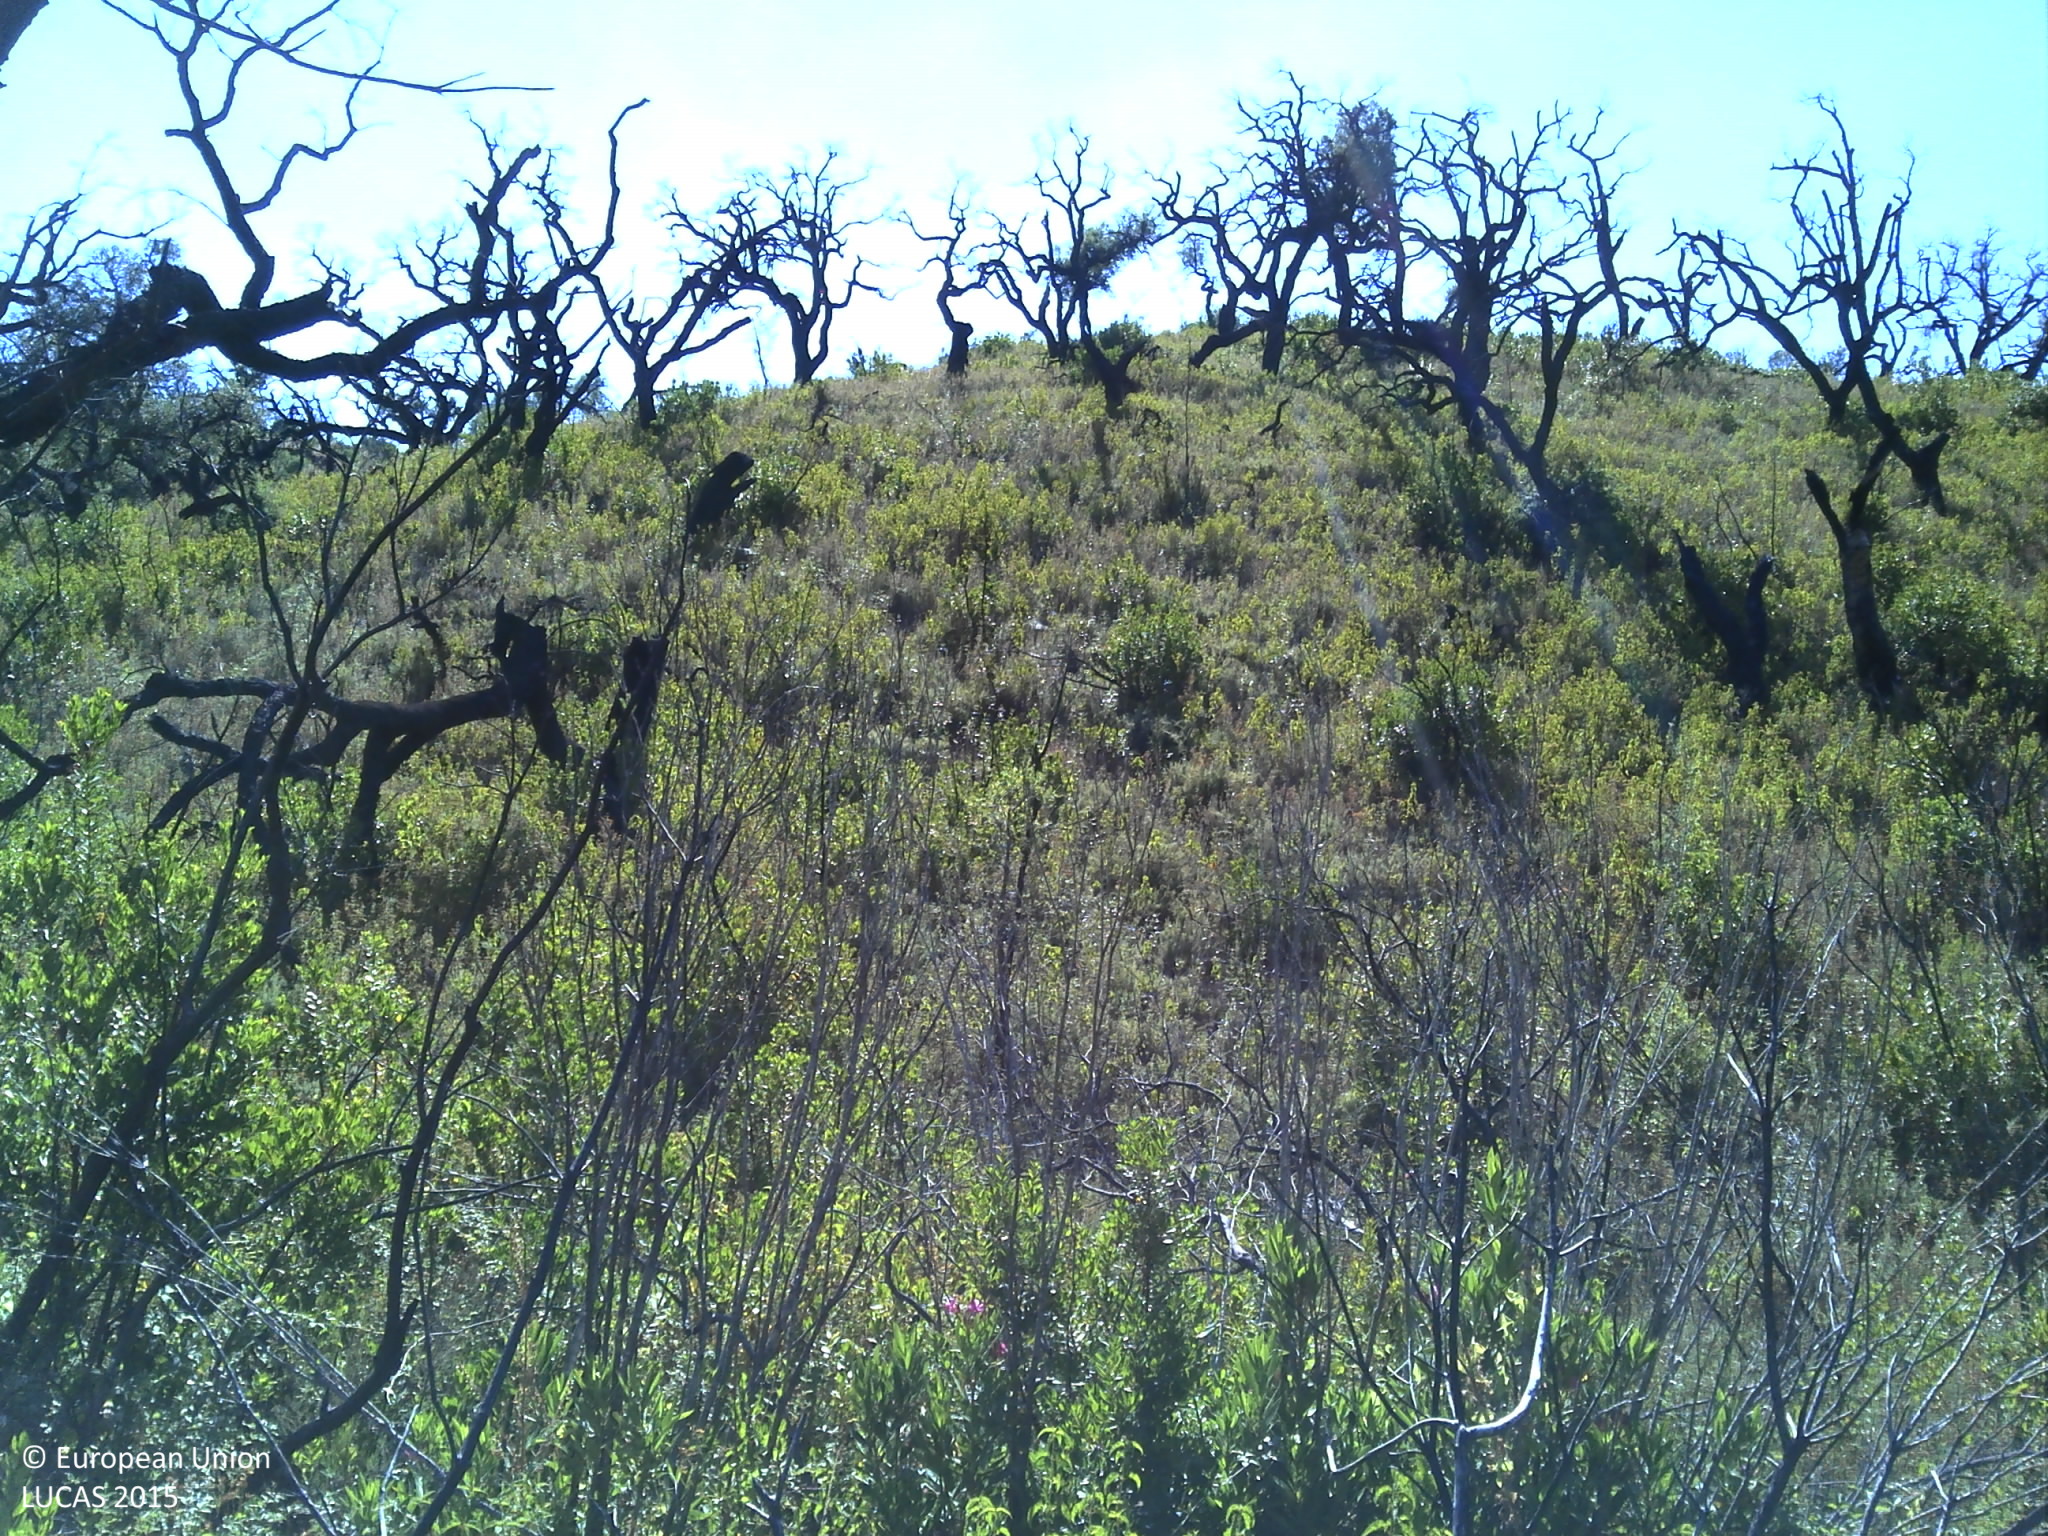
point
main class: Shrubland
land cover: Shrubland without tree cover
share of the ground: > 75 %
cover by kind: shrubs 90 %, herbaceous plants 5 %, unconsolidated bare surface 5 %
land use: Abandoned areas
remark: Burnt area
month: June
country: PT
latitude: 37.2103
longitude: -7.8483
